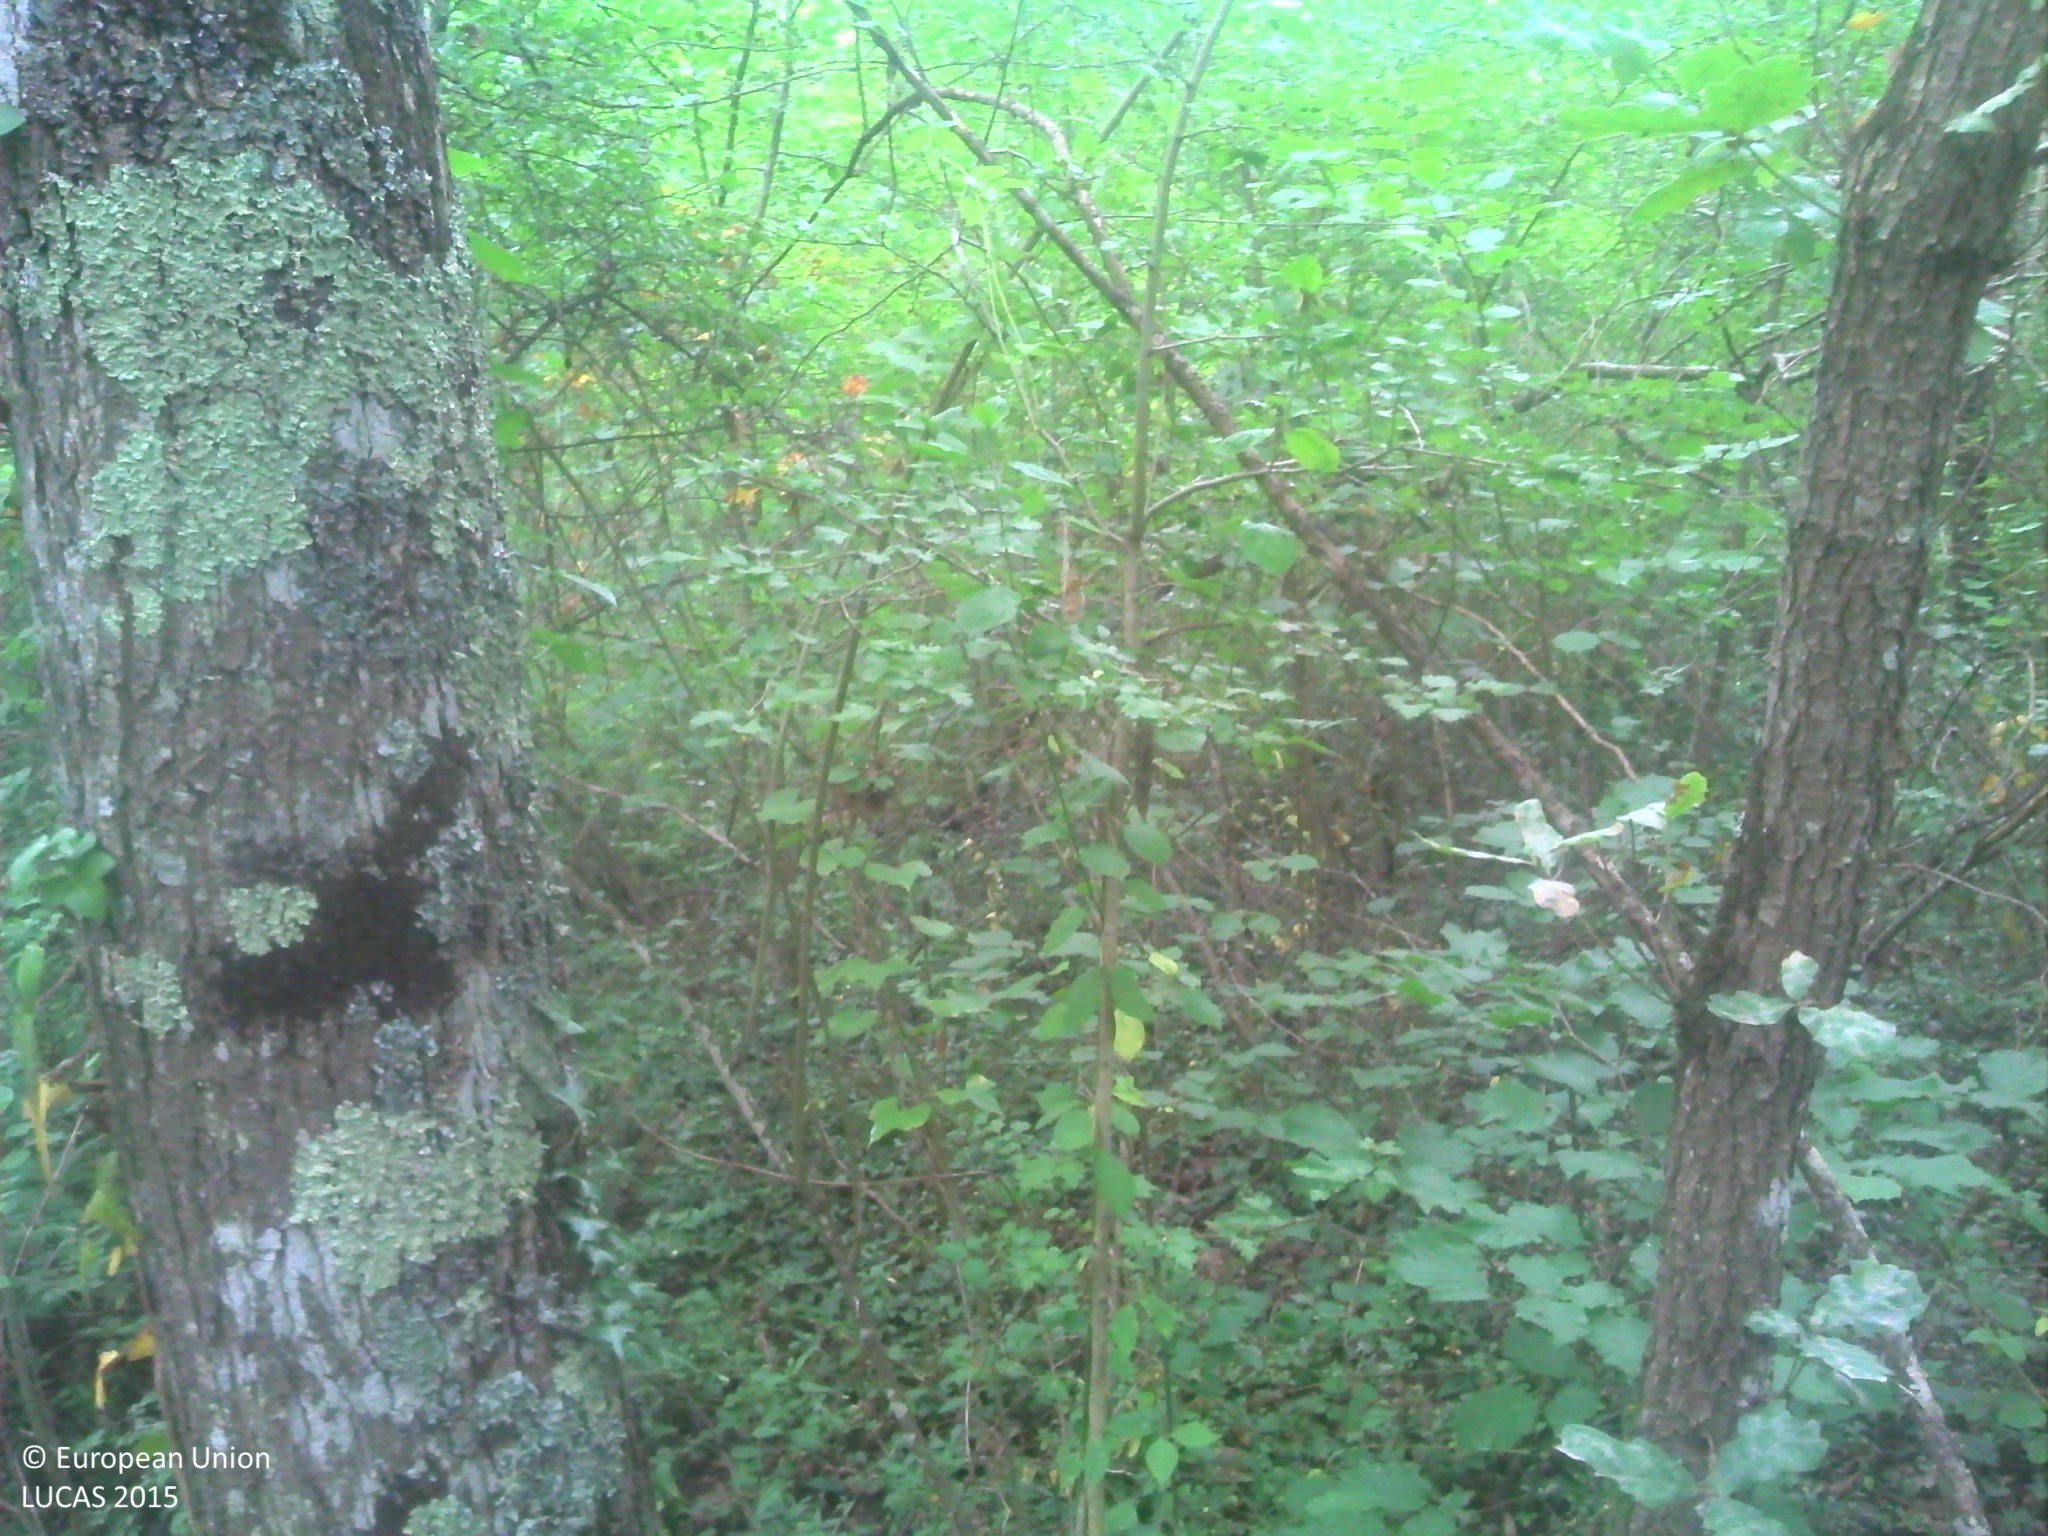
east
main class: Woodland
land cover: Broadleaved woodland
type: acidophilous oak and oak-birch forest
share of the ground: > 75 %
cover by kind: broadleaved forest trees 60 %, shrubs 30 %, herbaceous plants 10 %
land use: Forestry
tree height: > 5 m
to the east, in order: Broadleaved woodland; Fences; Broadleaved woodland; Grassland without tree/shrub cover; Fences; Broadleaved woodland; Shrubland with sparse tree cover; Broadleaved woodland
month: July
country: FR
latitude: 43.2910
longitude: 1.4632
